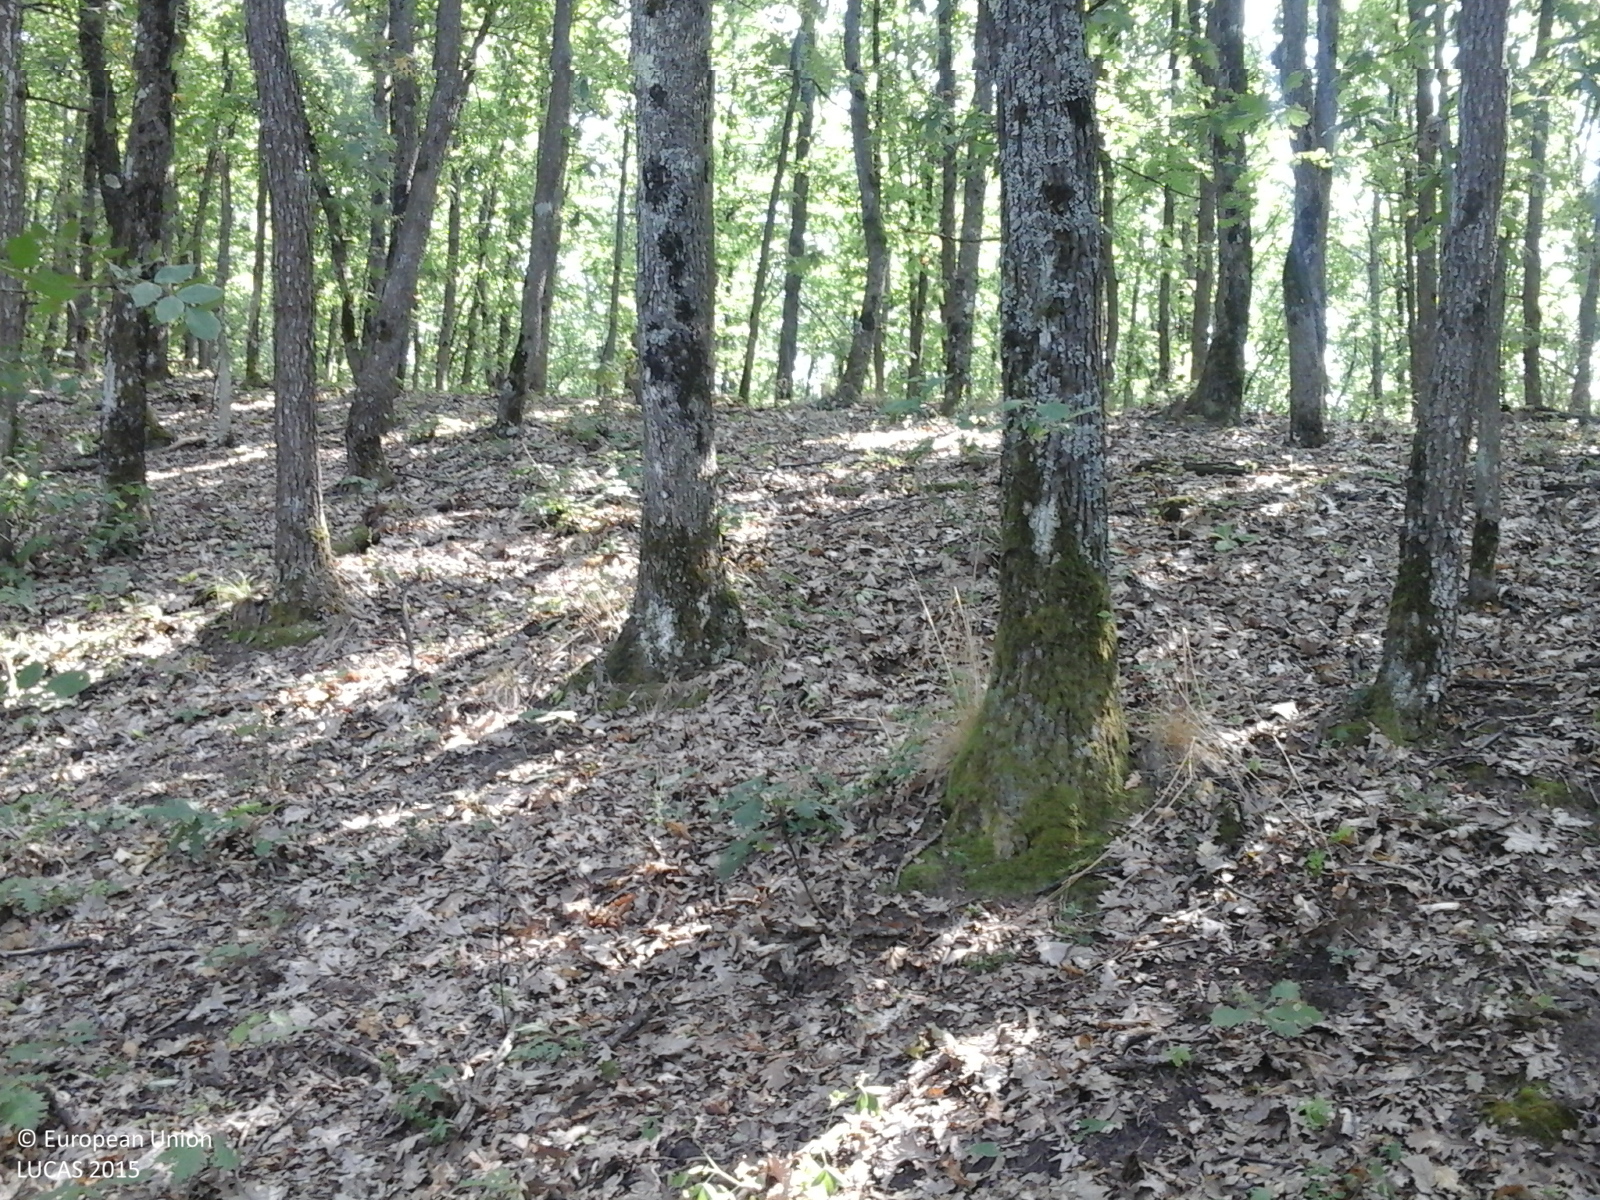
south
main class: Woodland
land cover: Broadleaved woodland
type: acidophilous oak and oak-birch forest
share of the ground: > 75 %
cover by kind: broadleaved forest trees 100 %
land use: Forestry
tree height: > 5 m
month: August
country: RO
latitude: 44.6954
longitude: 23.8537
